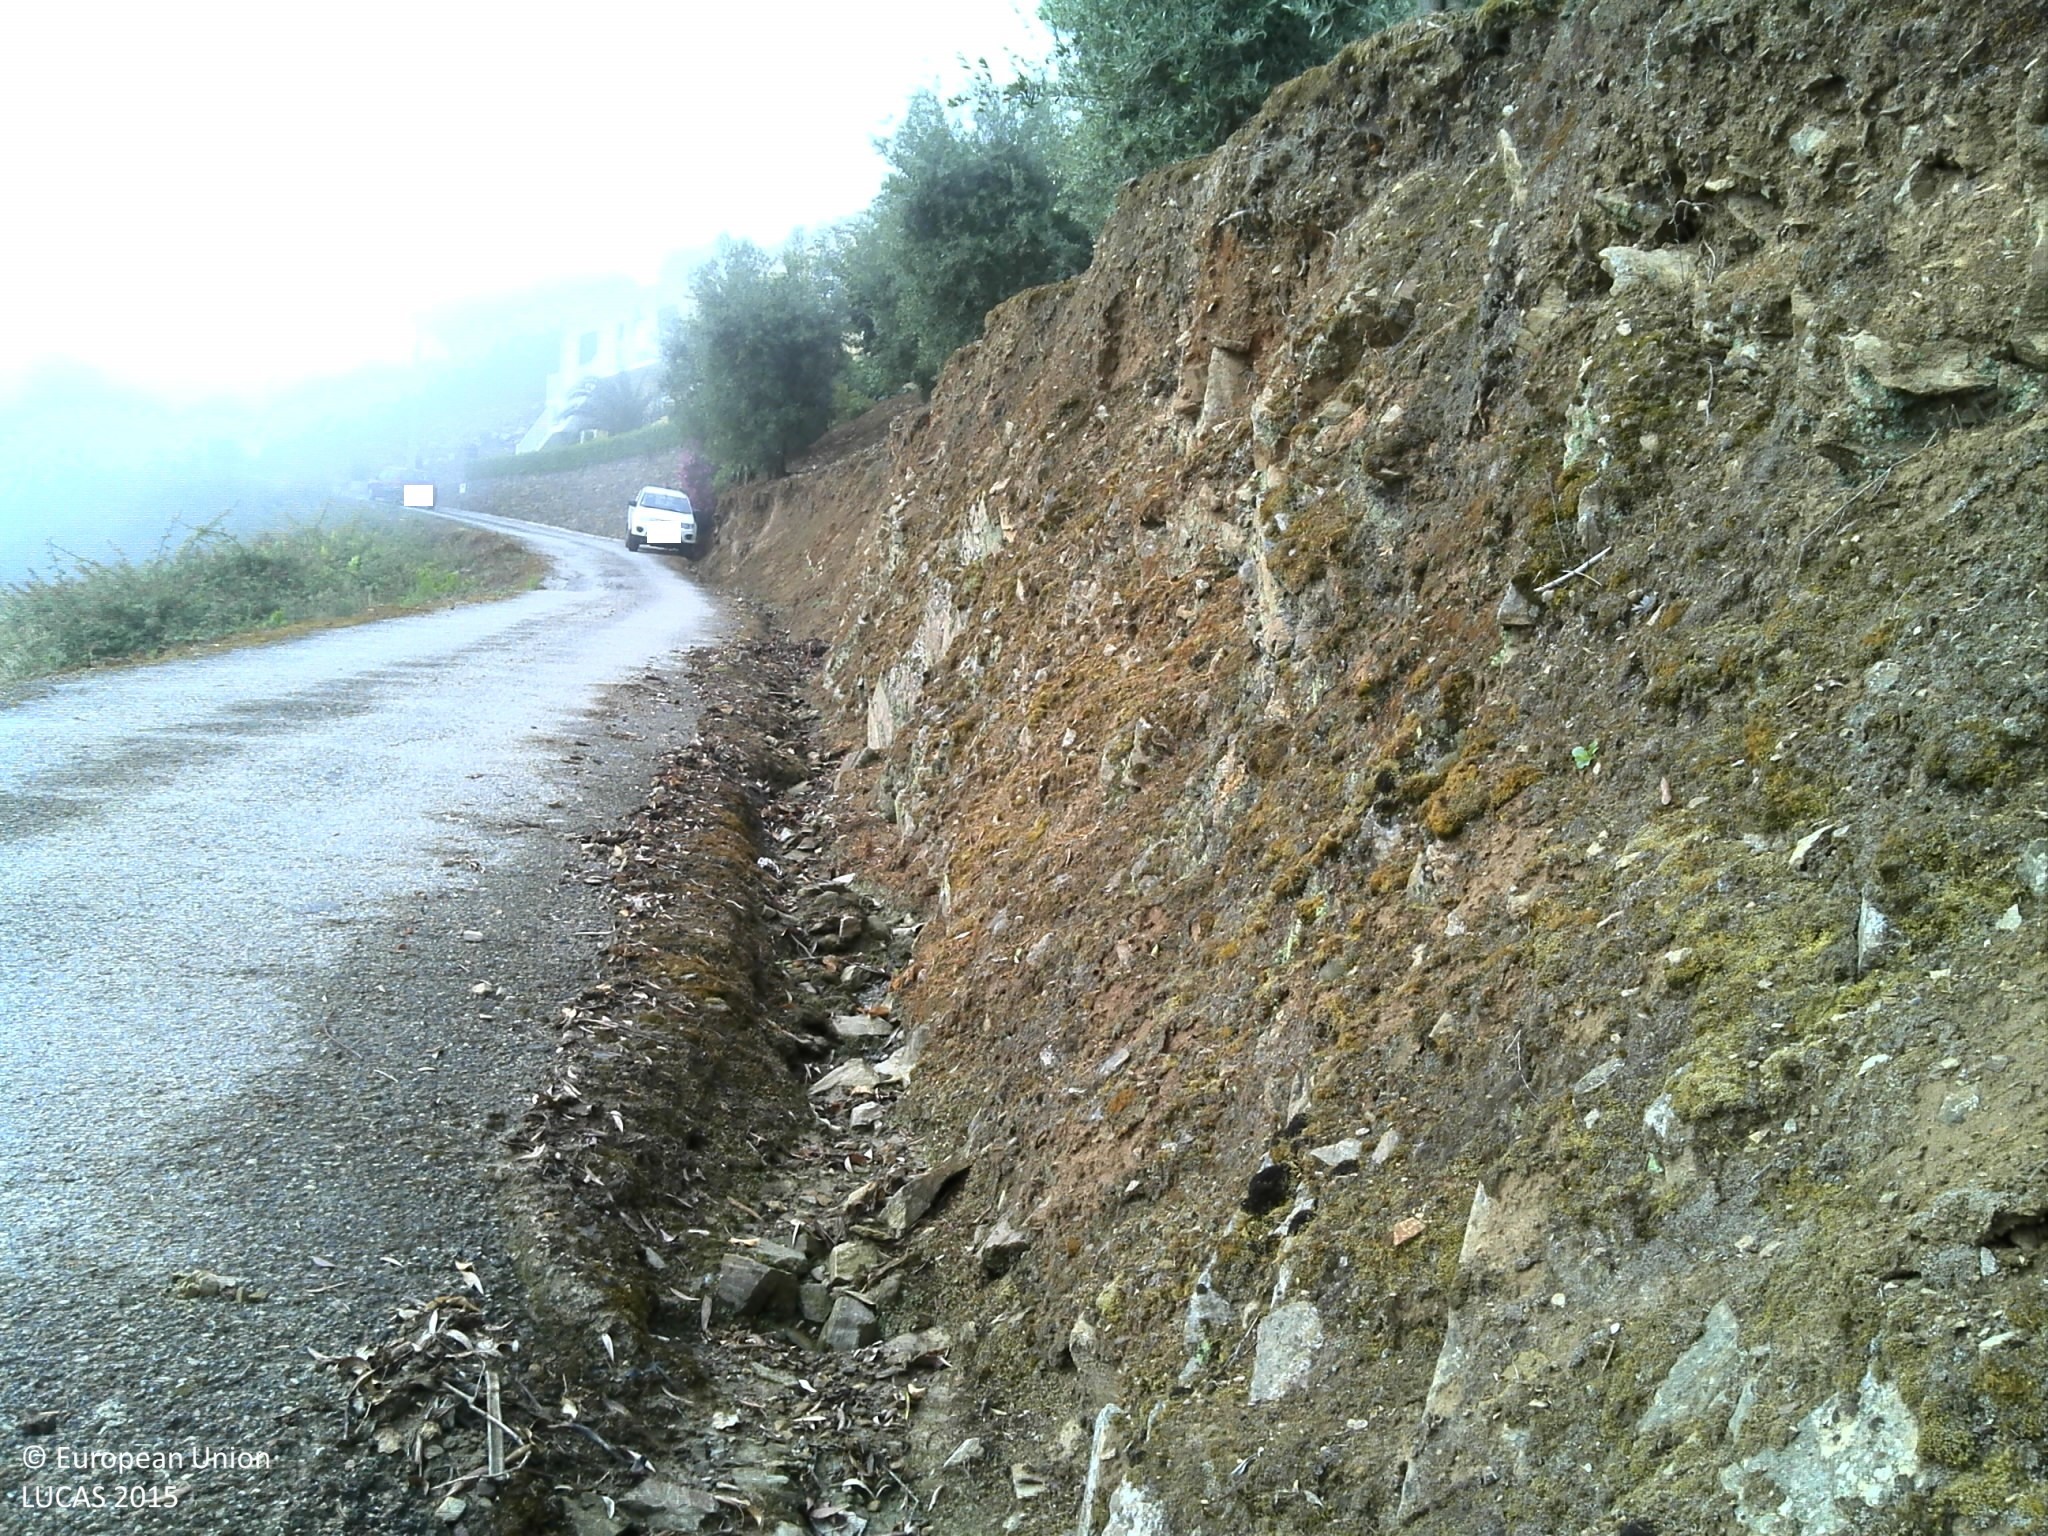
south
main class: Cropland
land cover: Olive groves
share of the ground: < 10 %
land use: Agriculture (excluding fallow land and kitchen gardens)
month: June
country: PT
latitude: 41.1220
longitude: -7.5719
